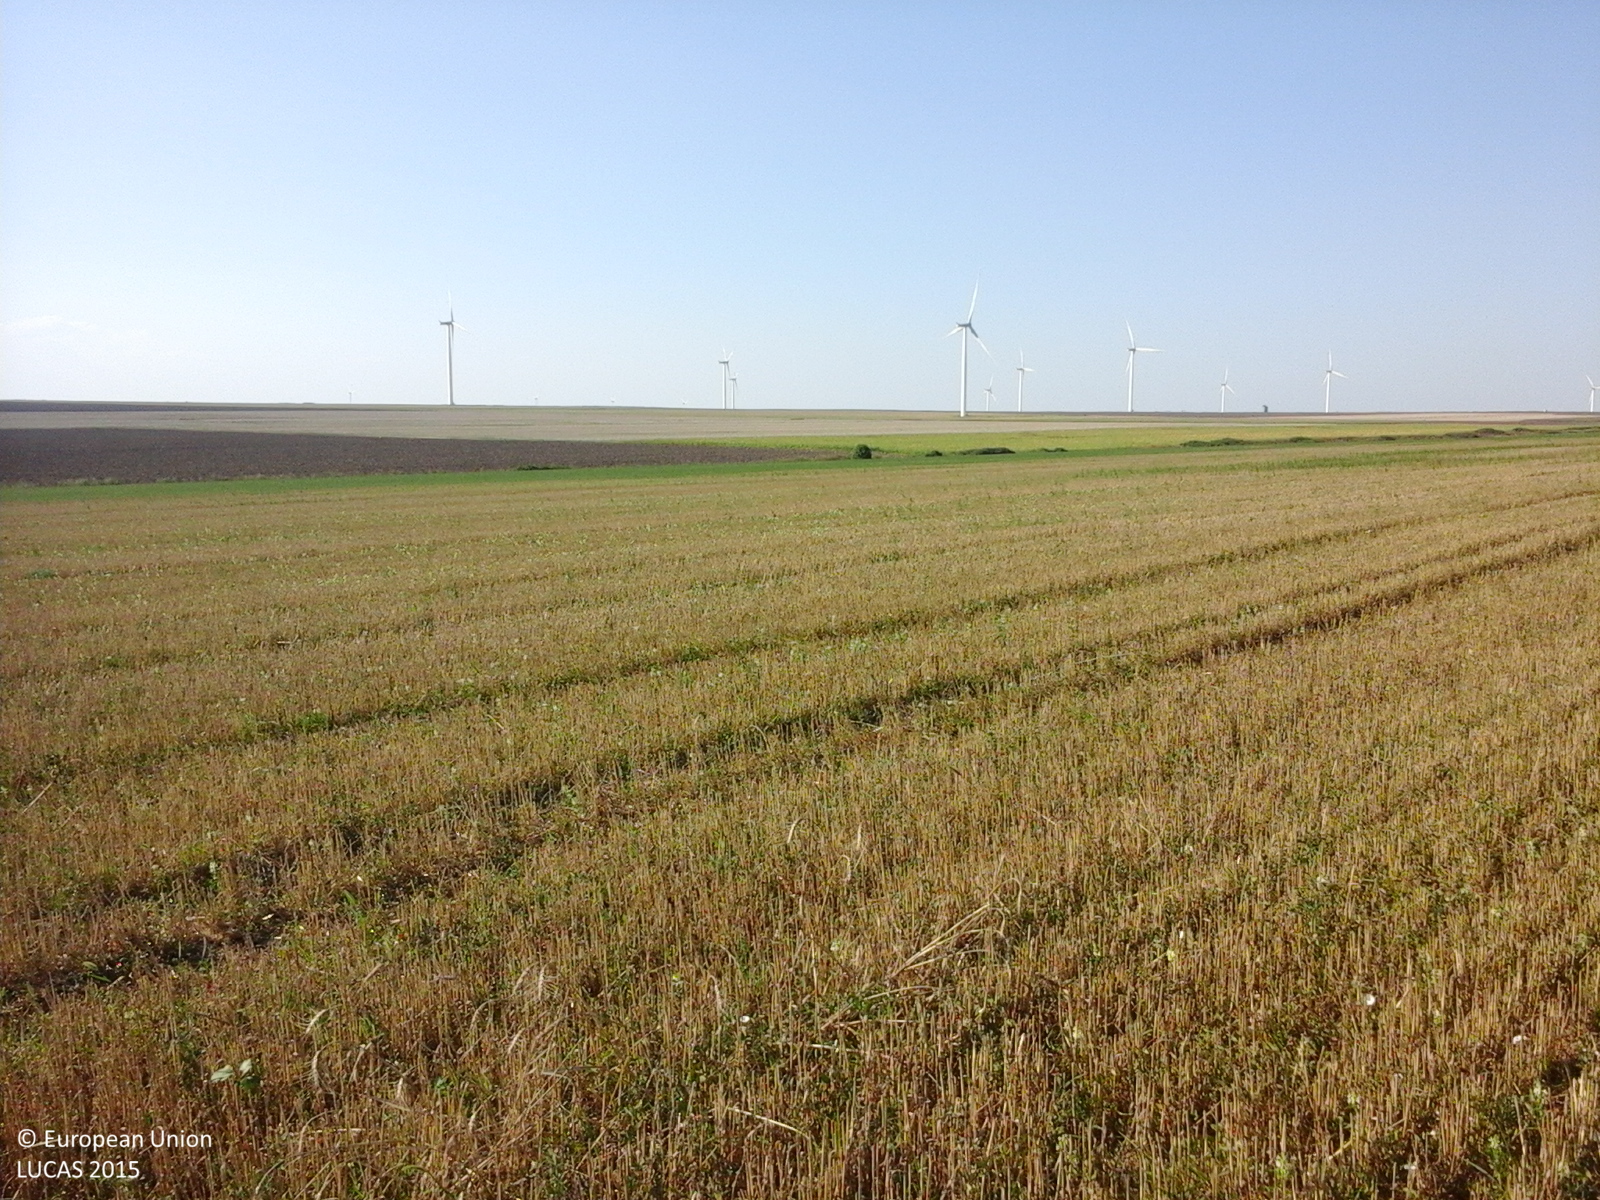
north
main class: Cropland
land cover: Common wheat
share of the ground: > 75 %
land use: Agriculture (excluding fallow land and kitchen gardens)
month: August
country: RO
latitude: 44.3369
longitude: 28.3660
